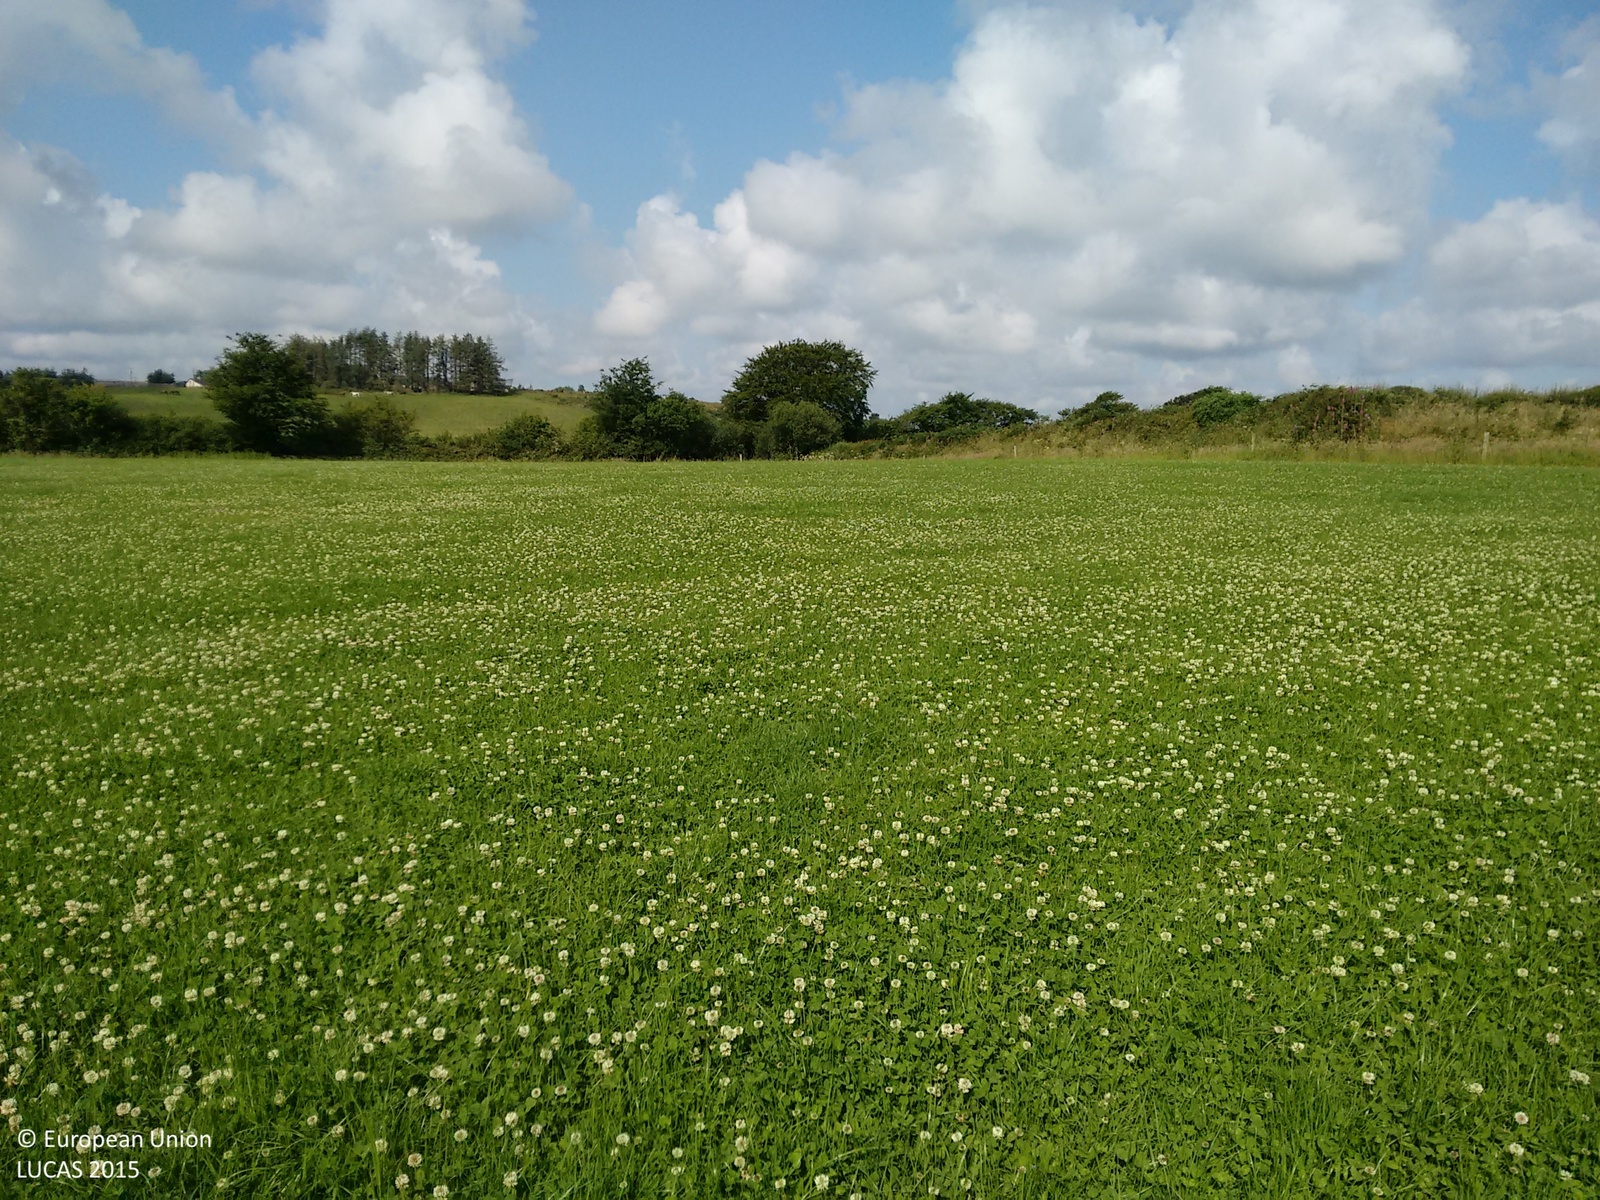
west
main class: Grassland
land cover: Grassland without tree/shrub cover
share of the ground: > 75 %
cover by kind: herbaceous plants 100 %
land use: Agriculture (excluding fallow land and kitchen gardens)
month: July
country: IE
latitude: 52.5696
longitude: -7.6475
